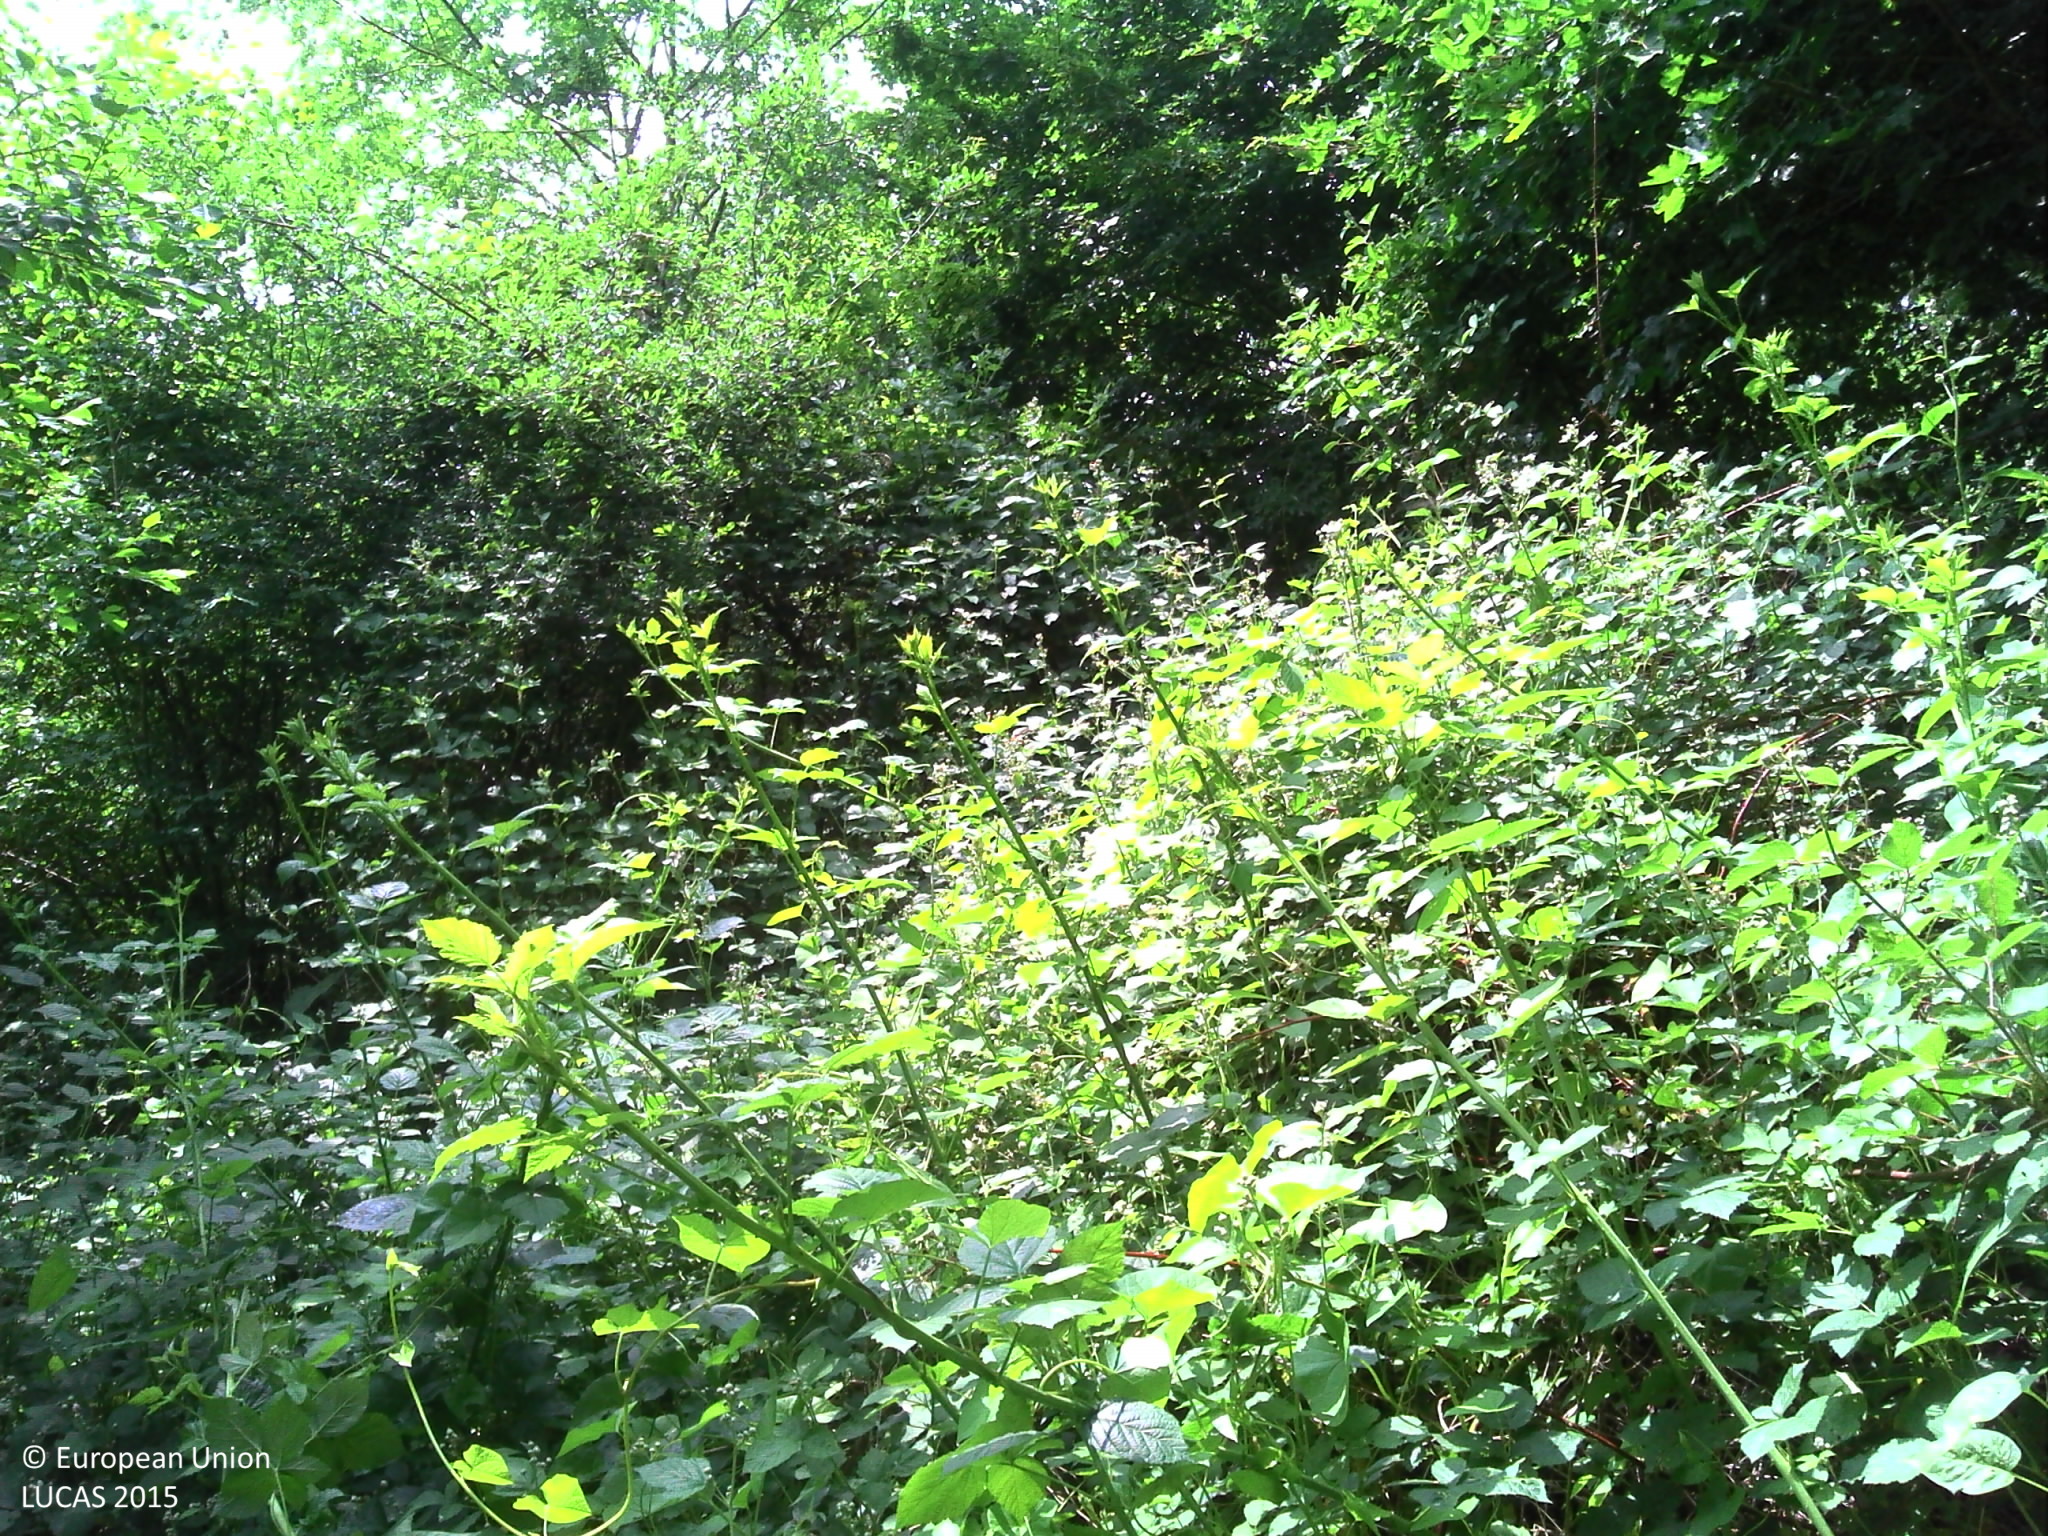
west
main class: Woodland
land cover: Broadleaved woodland
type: mesophytic deciduous forest
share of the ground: 50 - 75 %
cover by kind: broadleaved forest trees 65 %, shrubs 20 %, herbaceous plants 10 %, coniferous forest trees 5 %
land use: Forestry
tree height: > 5 m
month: June
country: BE
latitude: 50.3482
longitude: 5.5153
